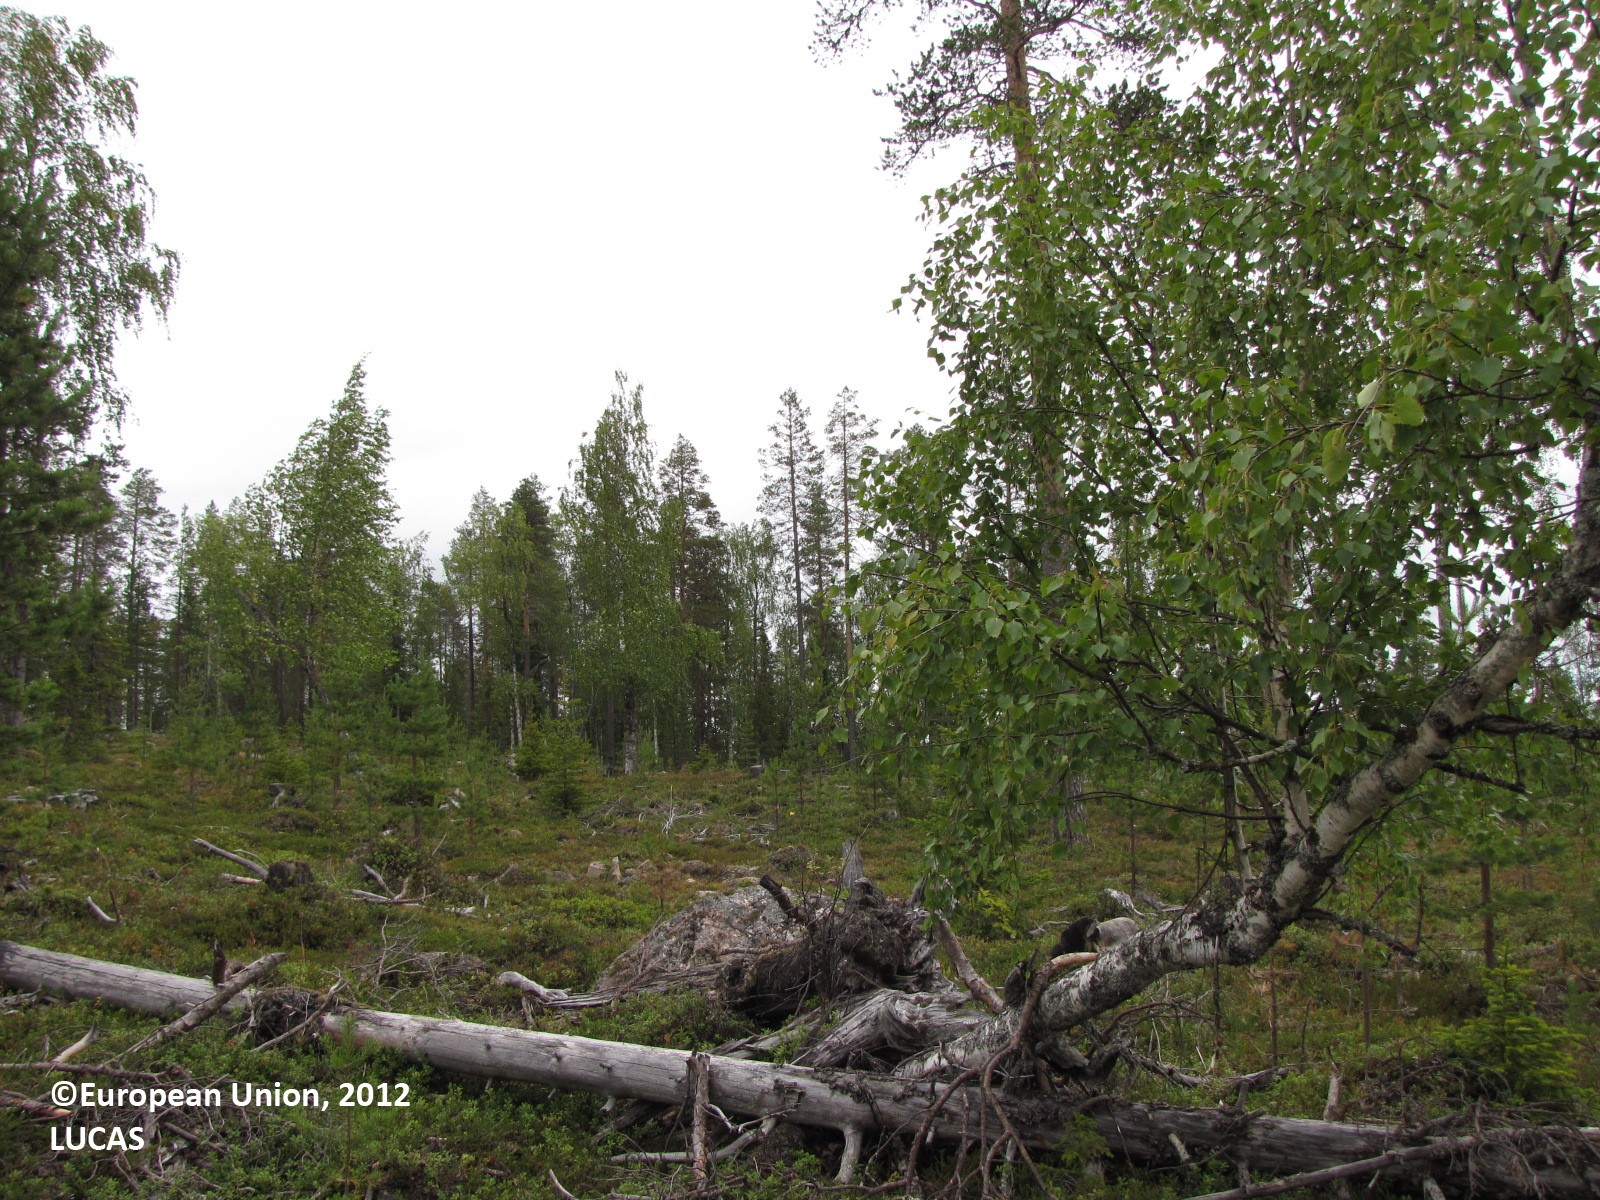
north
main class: Woodland
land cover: Pine dominated mixed woodland
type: boreal forest
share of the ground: 25 - 50 %
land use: Forestry
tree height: > 5 m
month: August
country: FI
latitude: 67.0910
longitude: 25.3143
